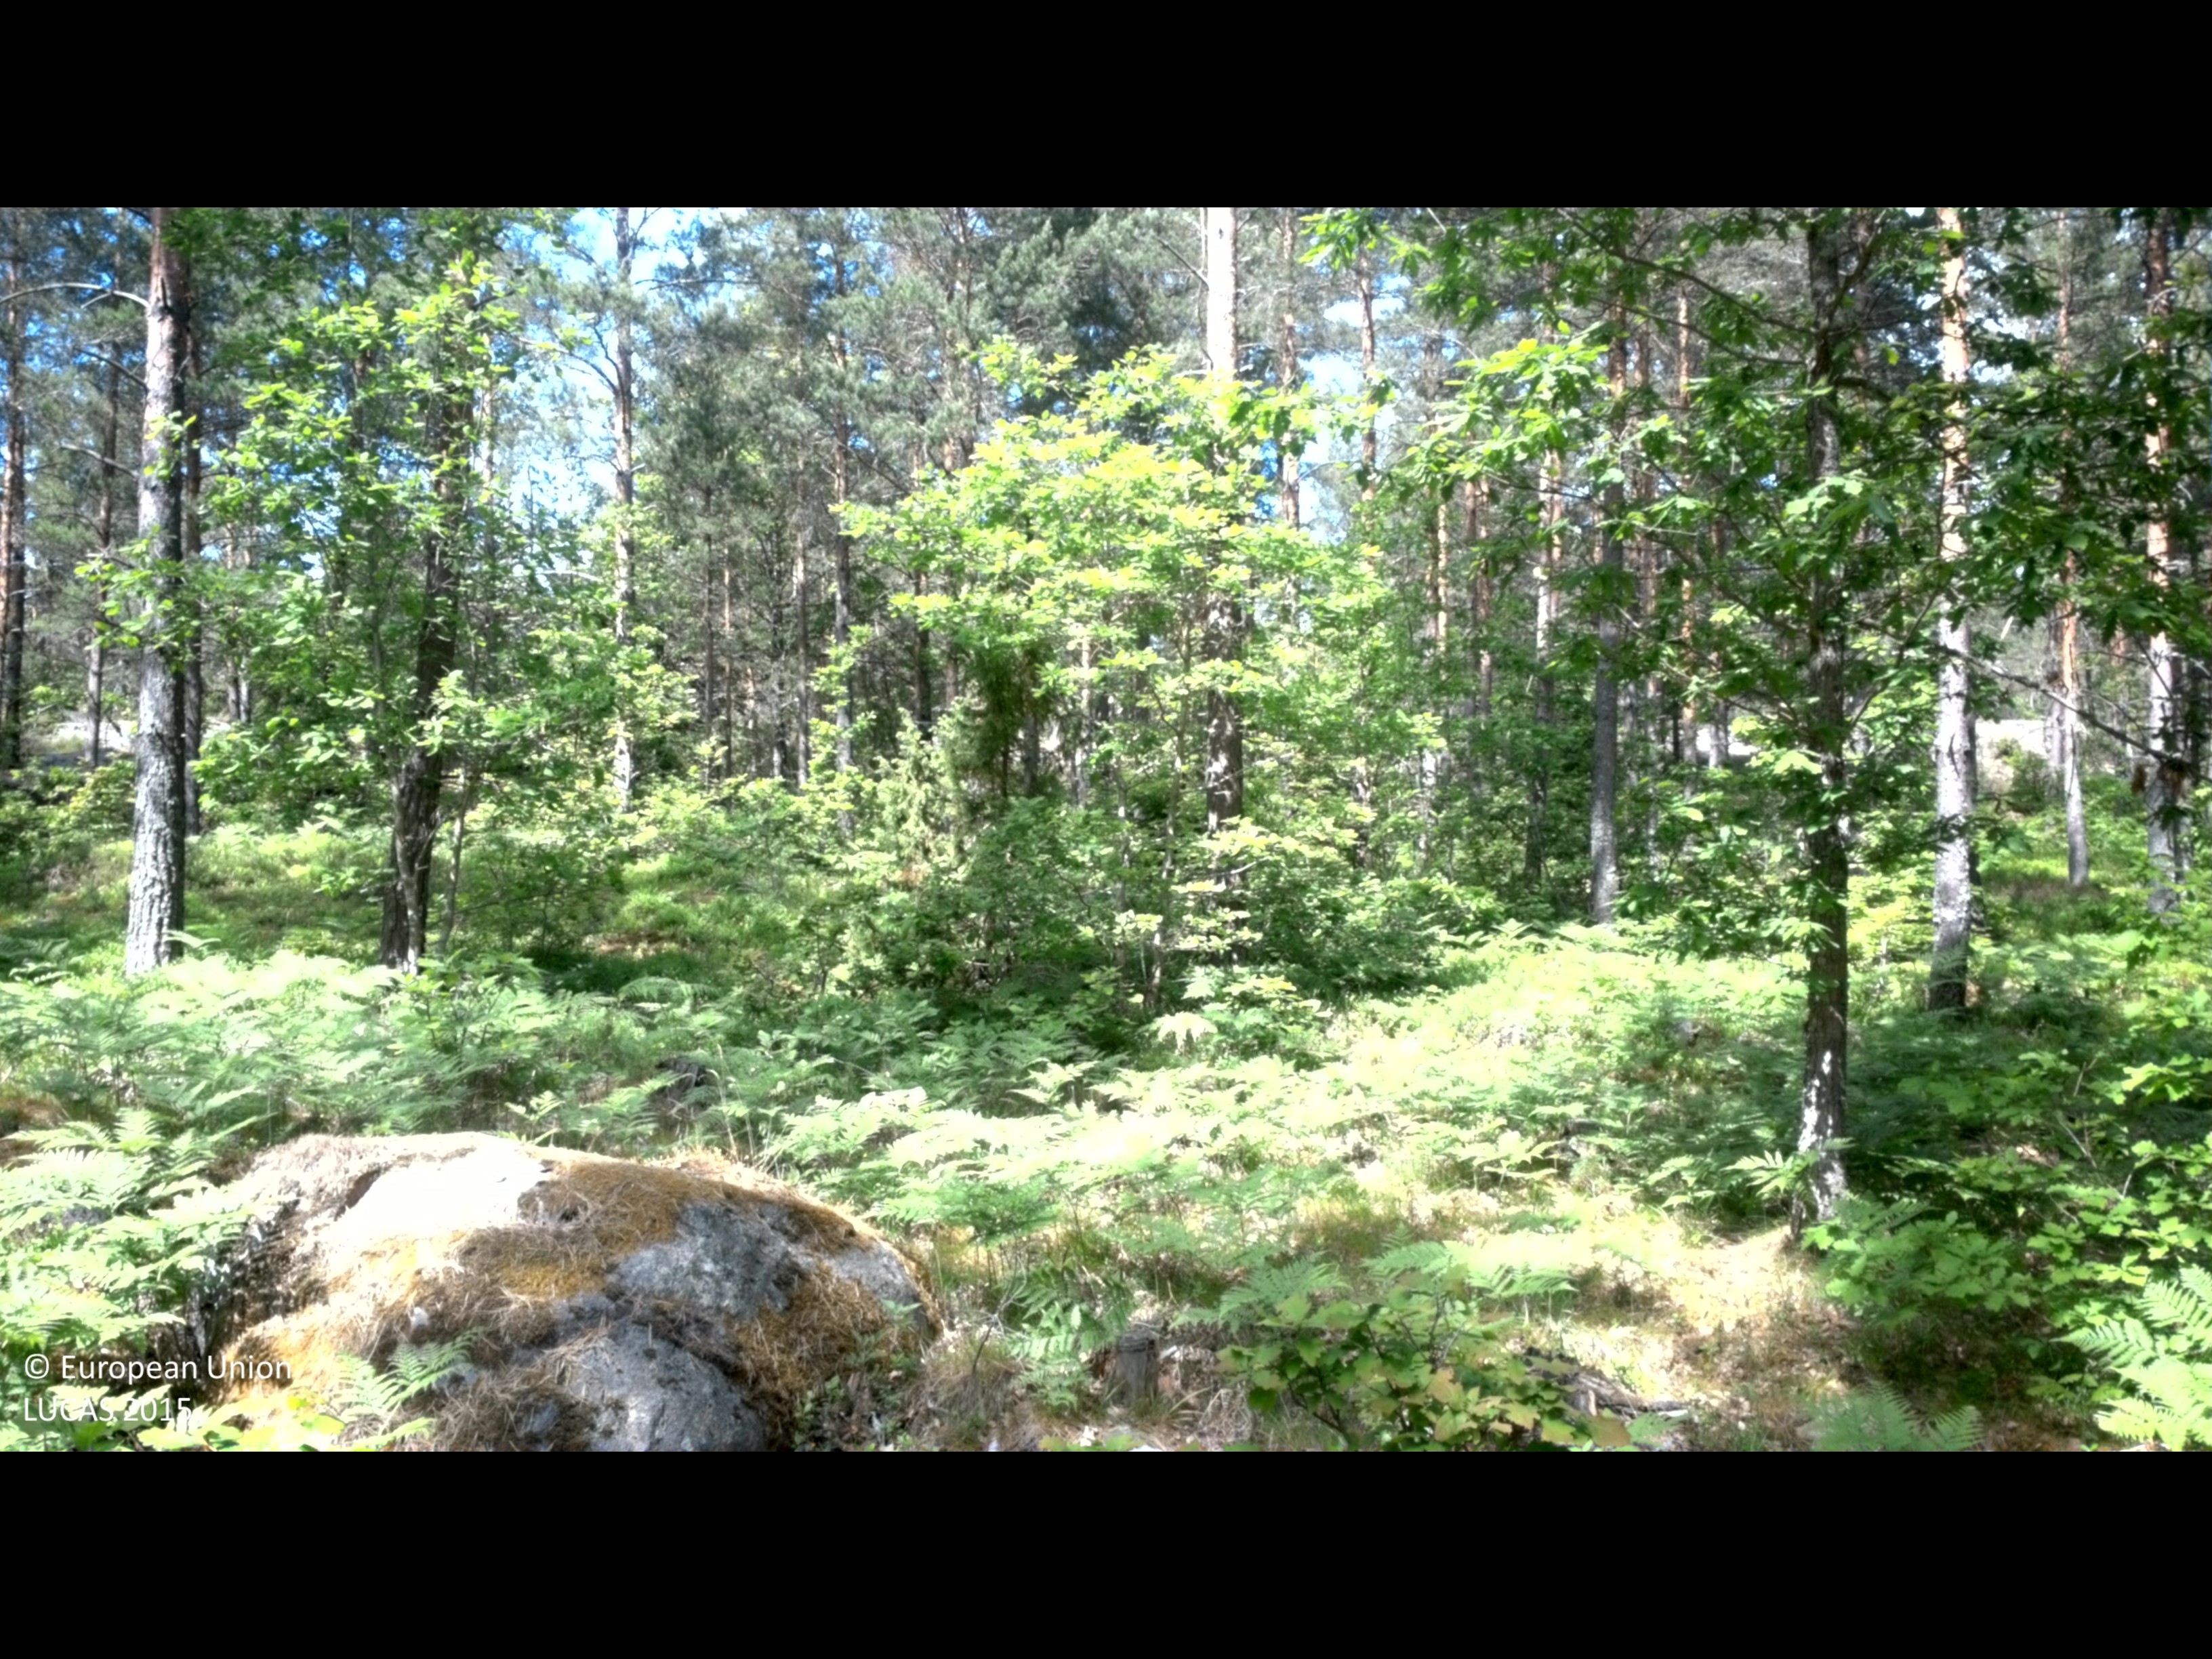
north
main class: Woodland
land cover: Pine dominated mixed woodland
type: boreal forest
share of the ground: 50 - 75 %
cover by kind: coniferous forest trees 45 %, broadleaved forest trees 20 %, herbaceous plants 15 %, shrubs 10 %, lichens and mosses 10 %
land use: Forestry
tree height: > 5 m
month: June
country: SE
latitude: 57.6072
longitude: 16.5765
